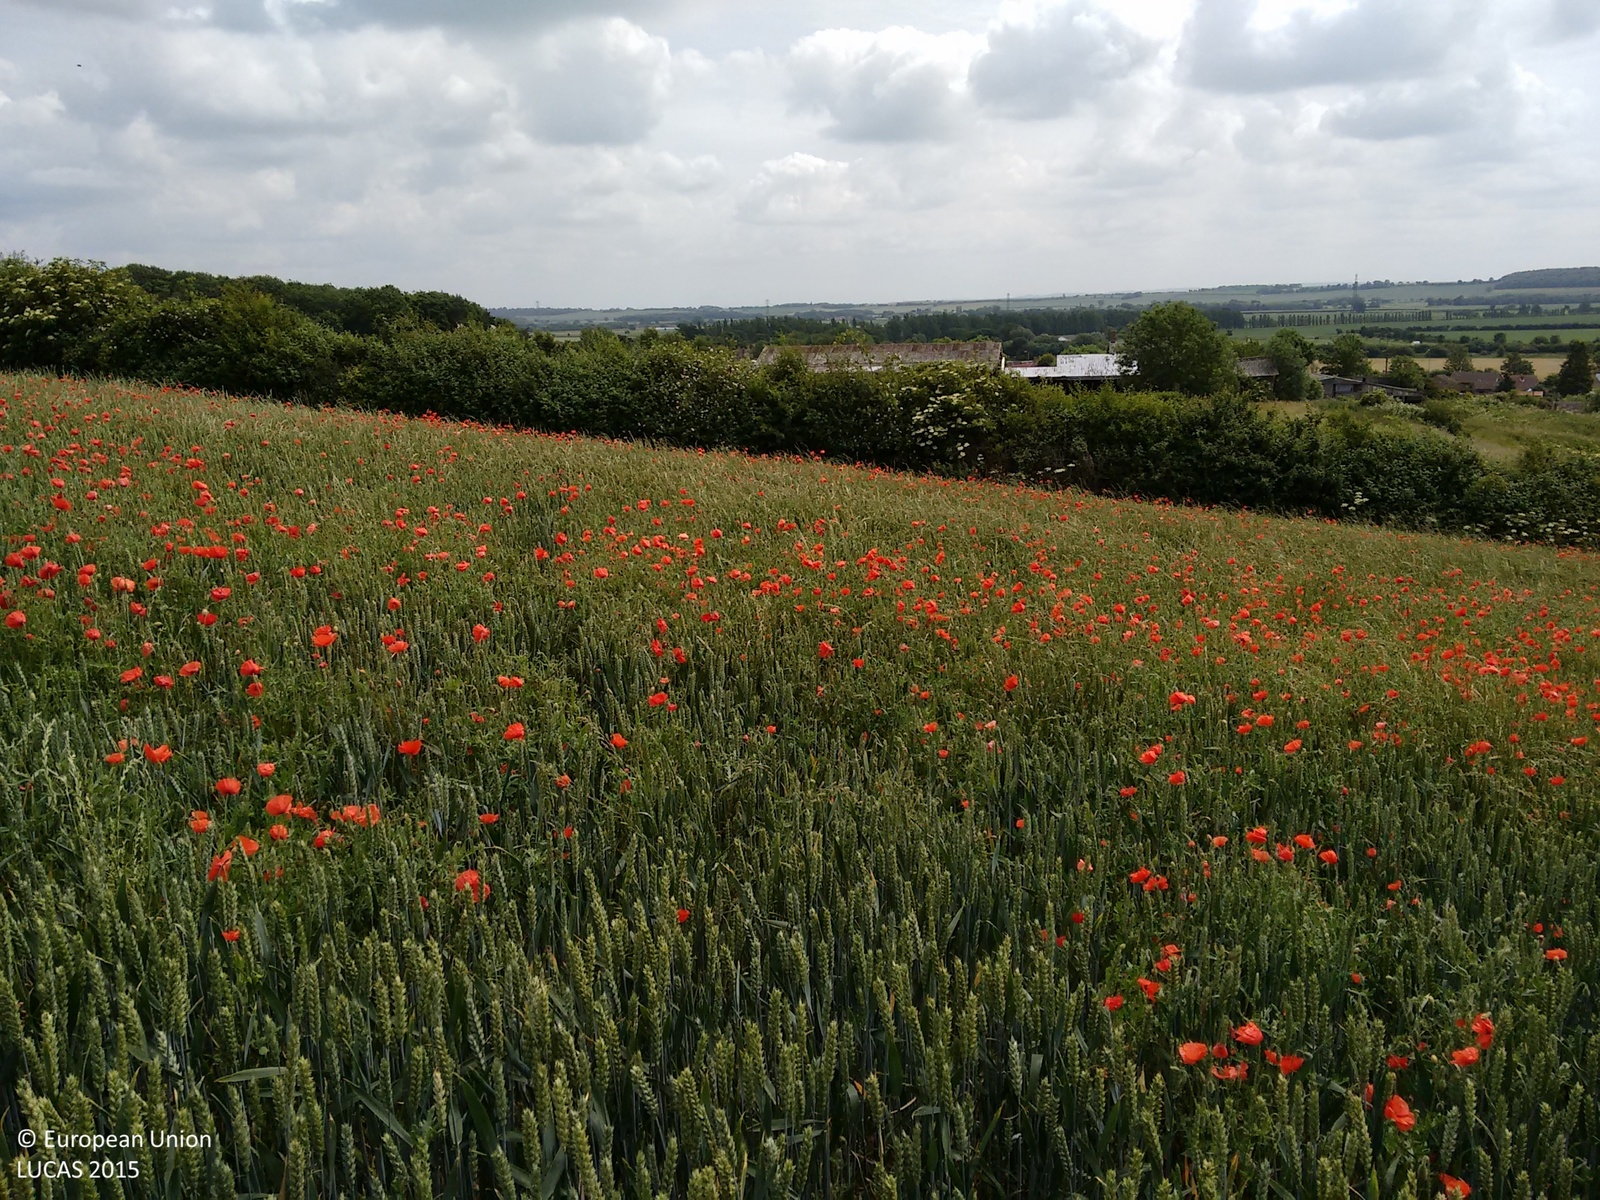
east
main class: Cropland
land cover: Common wheat
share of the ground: > 75 %
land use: Agriculture (excluding fallow land and kitchen gardens)
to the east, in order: Common wheat; Grass margins; Ditches and canals; Managed hedges; Grassland without tree/shrub cover; Ditches and canals; Grass margins; Rape and turnip rape
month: June
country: GB
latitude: 52.9851
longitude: -1.0523
